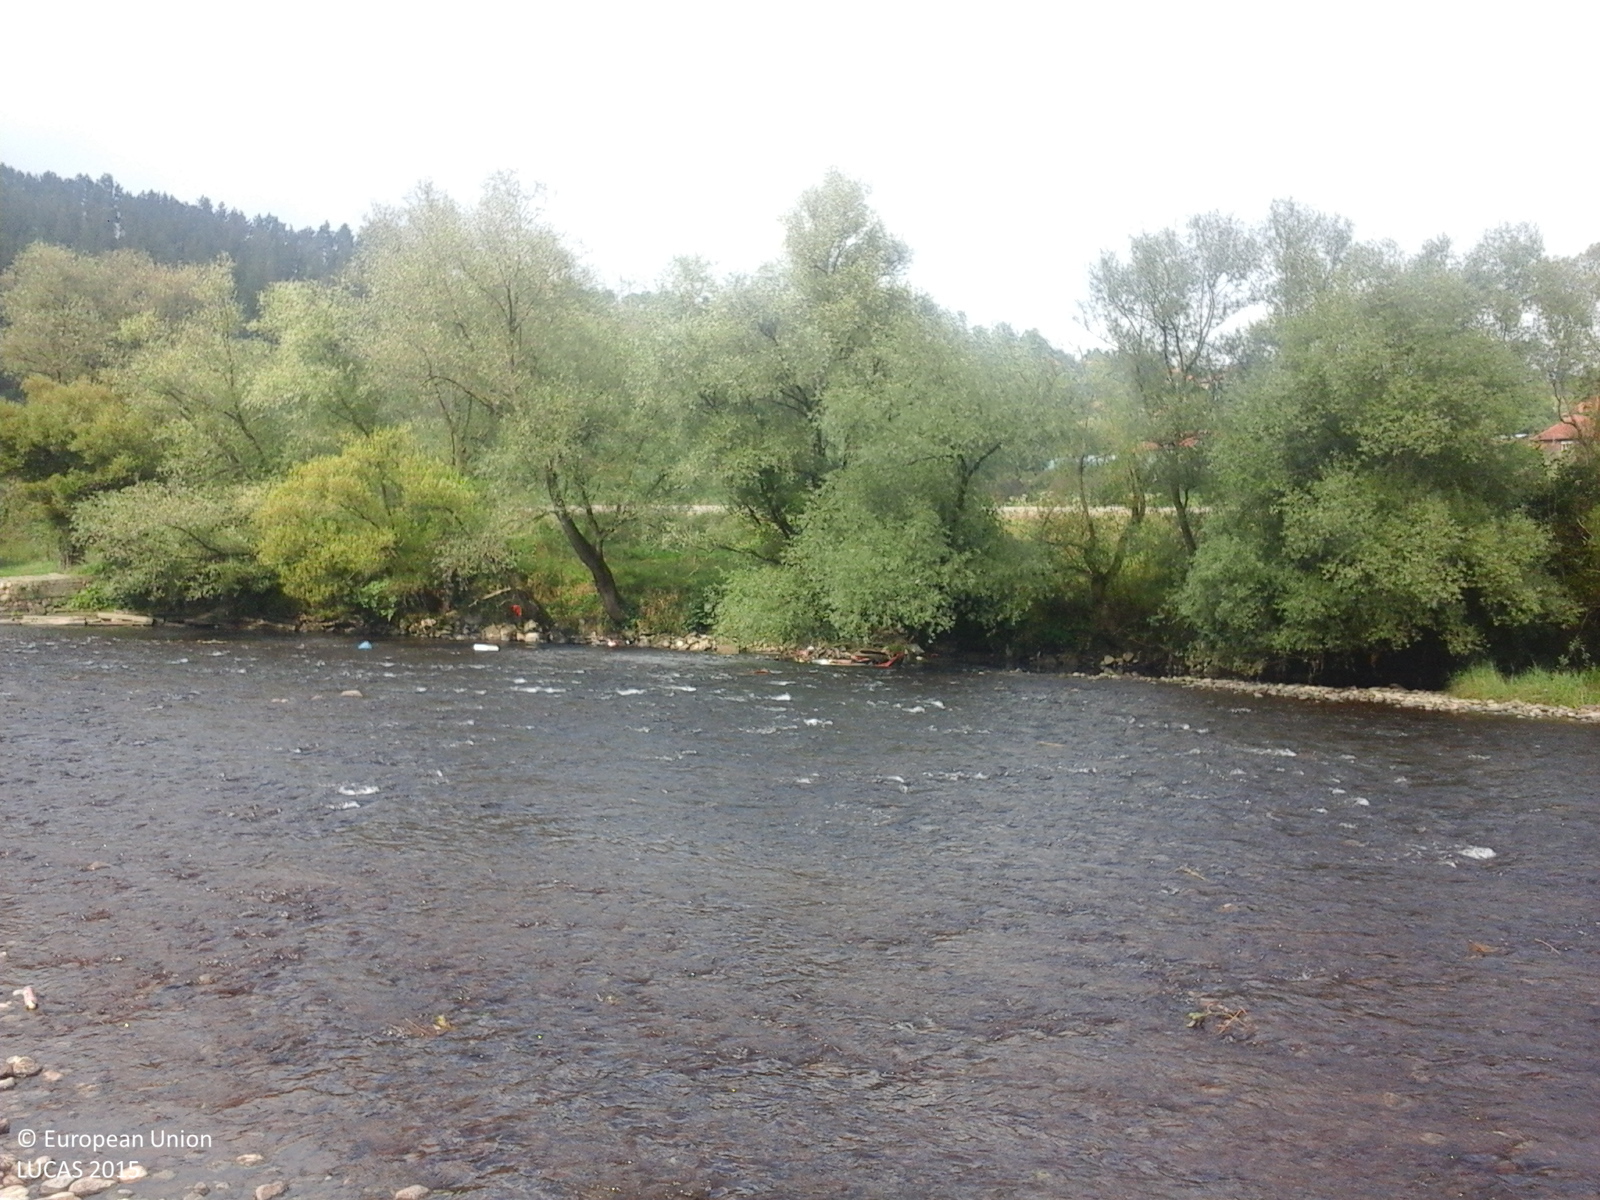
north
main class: Grassland
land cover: Grassland without tree/shrub cover
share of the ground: > 75 %
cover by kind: herbaceous plants 100 %
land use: Agriculture (excluding fallow land and kitchen gardens)
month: September
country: RO
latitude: 46.9357
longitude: 22.5731
